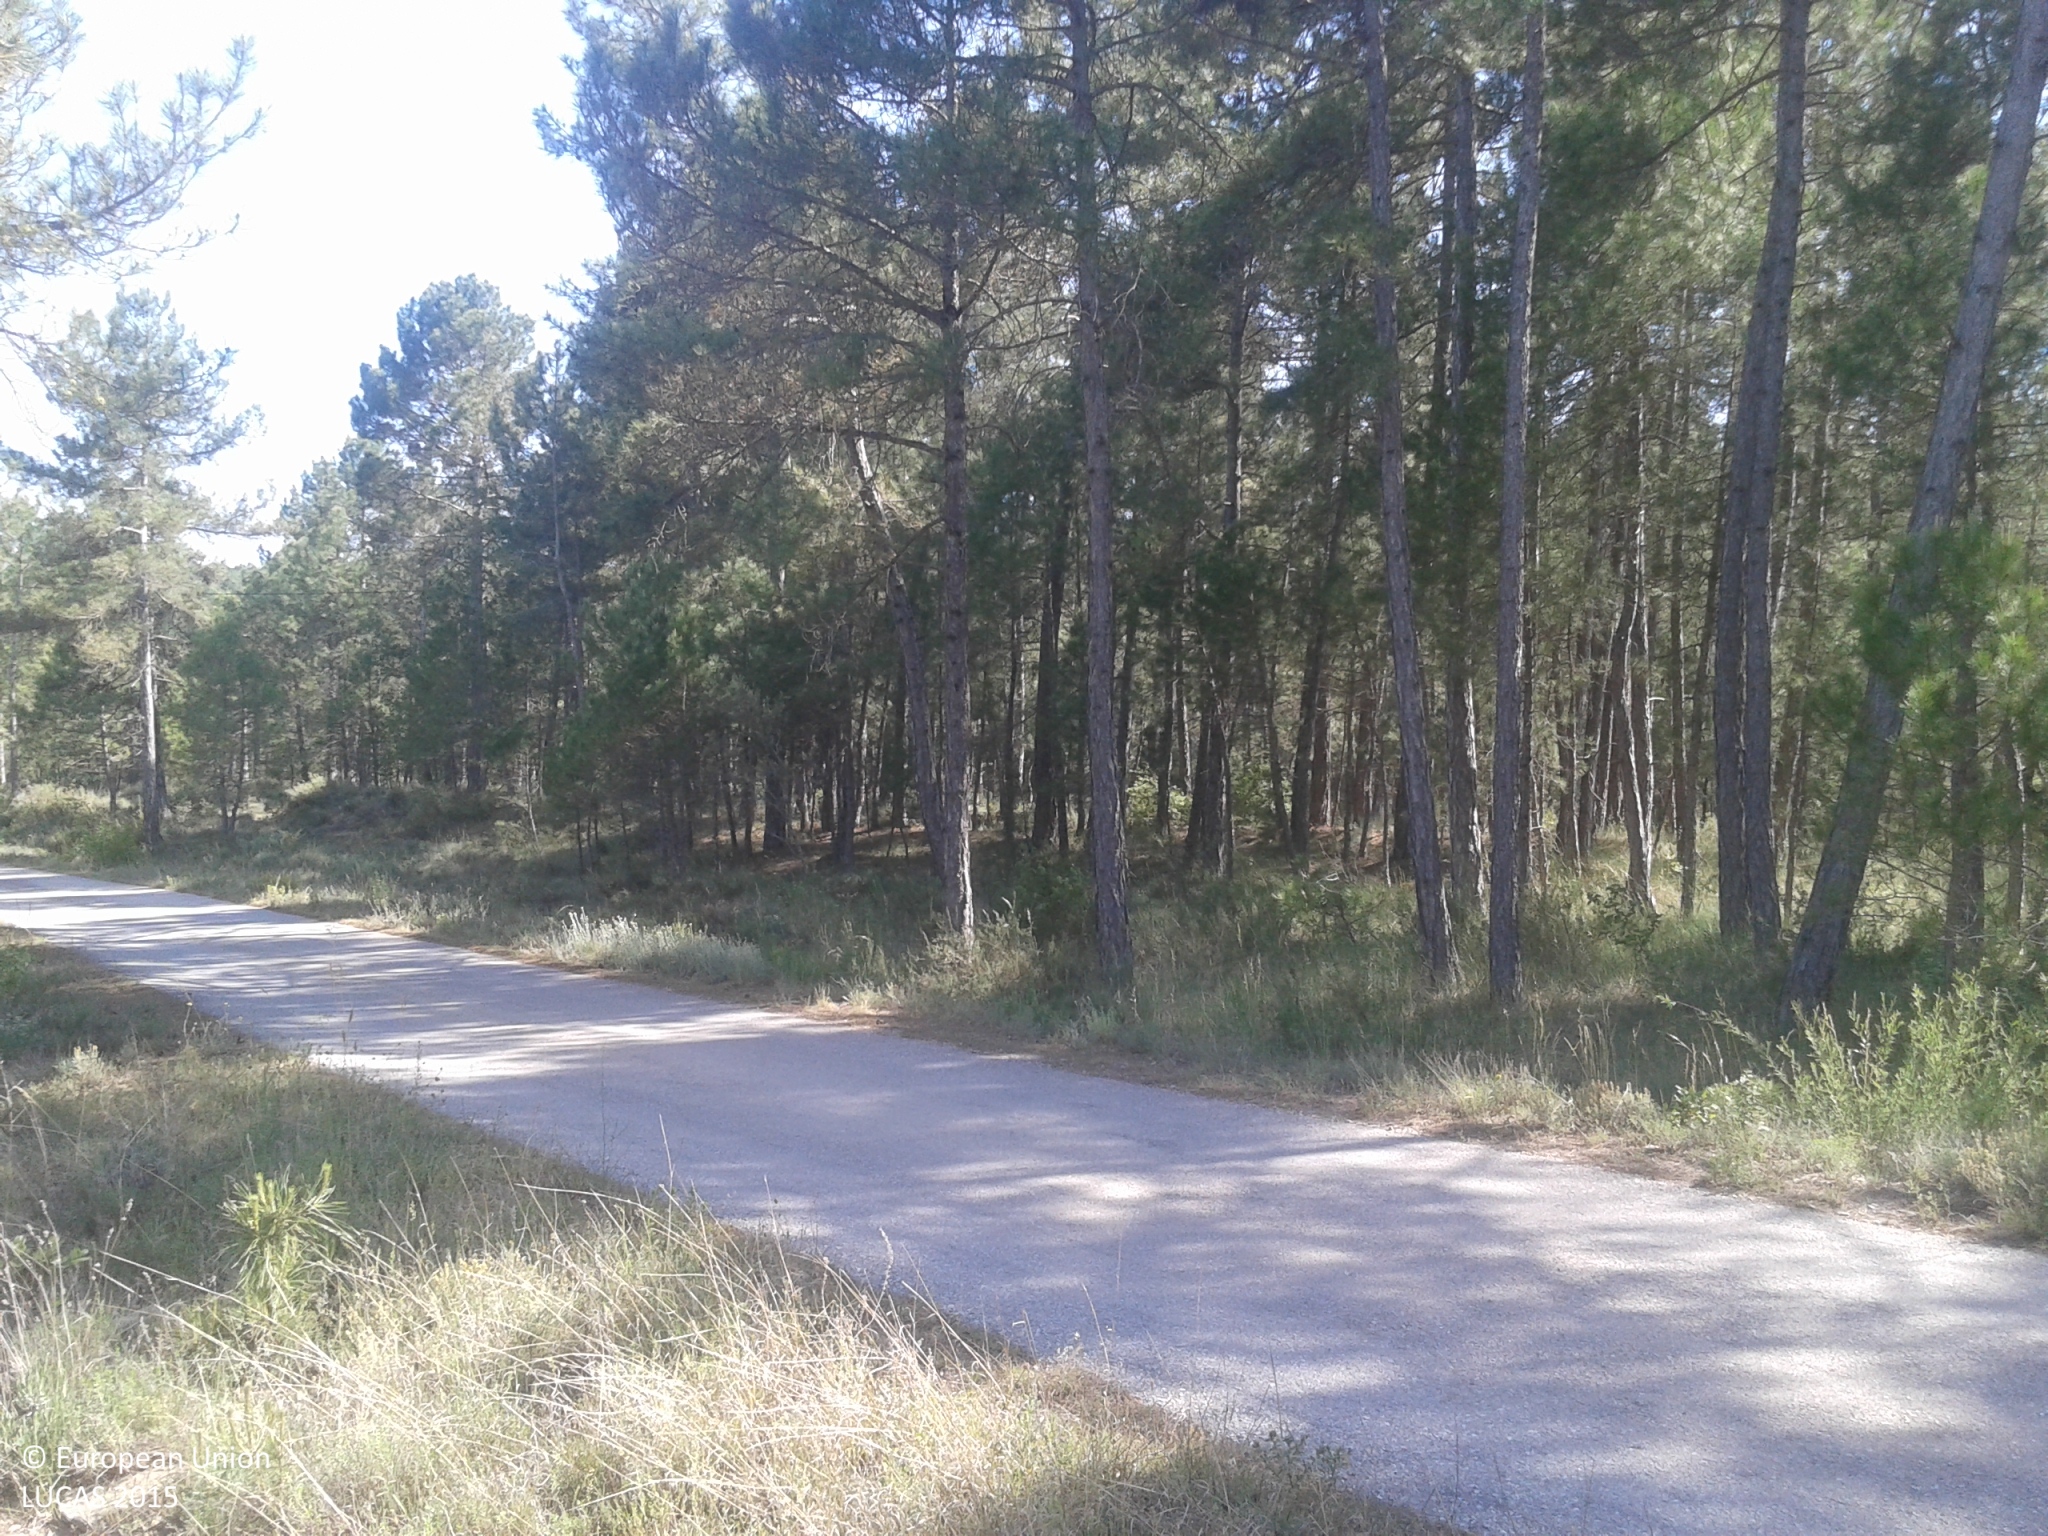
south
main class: Woodland
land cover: Pine dominated mixed woodland
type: coniferous forest of the mediterranean region
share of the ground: > 75 %
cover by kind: coniferous forest trees 60 %, broadleaved forest trees 25 %, shrubs 15 %
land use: Forestry
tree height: > 5 m
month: May
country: ES
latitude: 41.9999
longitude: 1.6465
